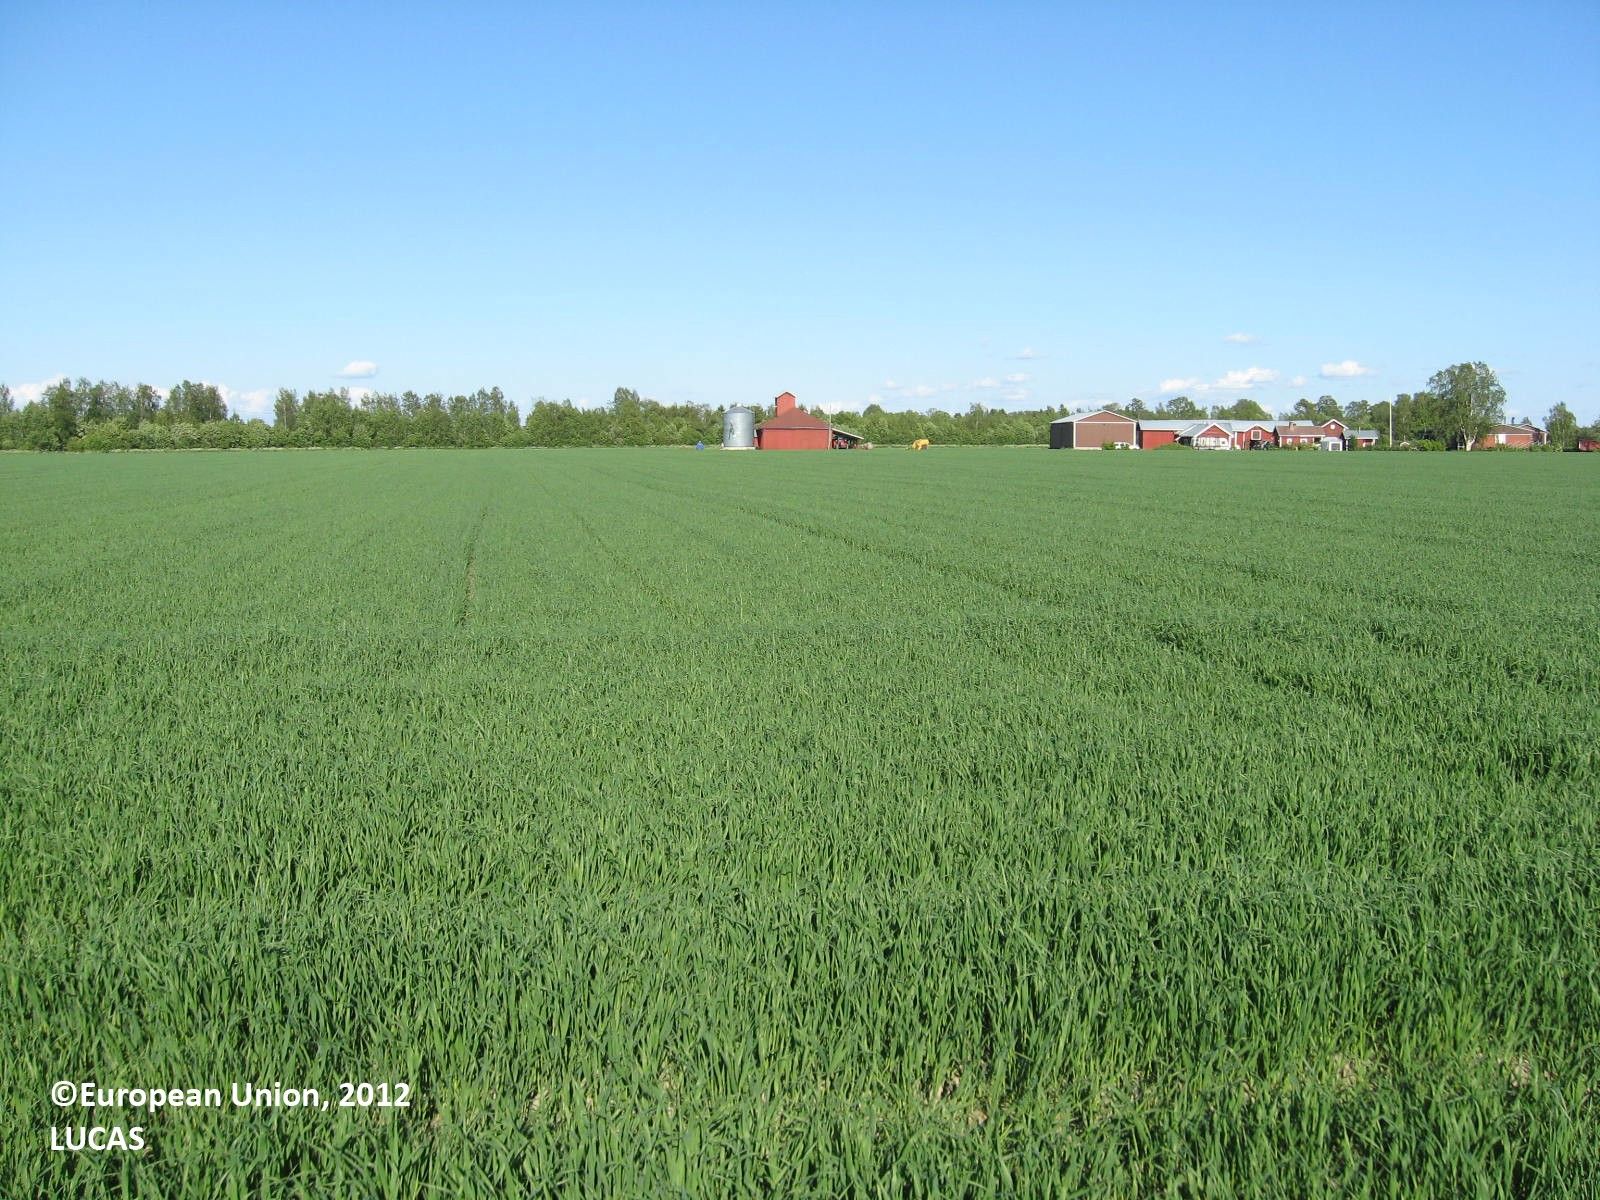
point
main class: Cropland
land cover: Oats
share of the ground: > 75 %
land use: Agriculture (excluding fallow land and kitchen gardens)
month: June
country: FI
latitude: 62.9970
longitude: 21.9088
